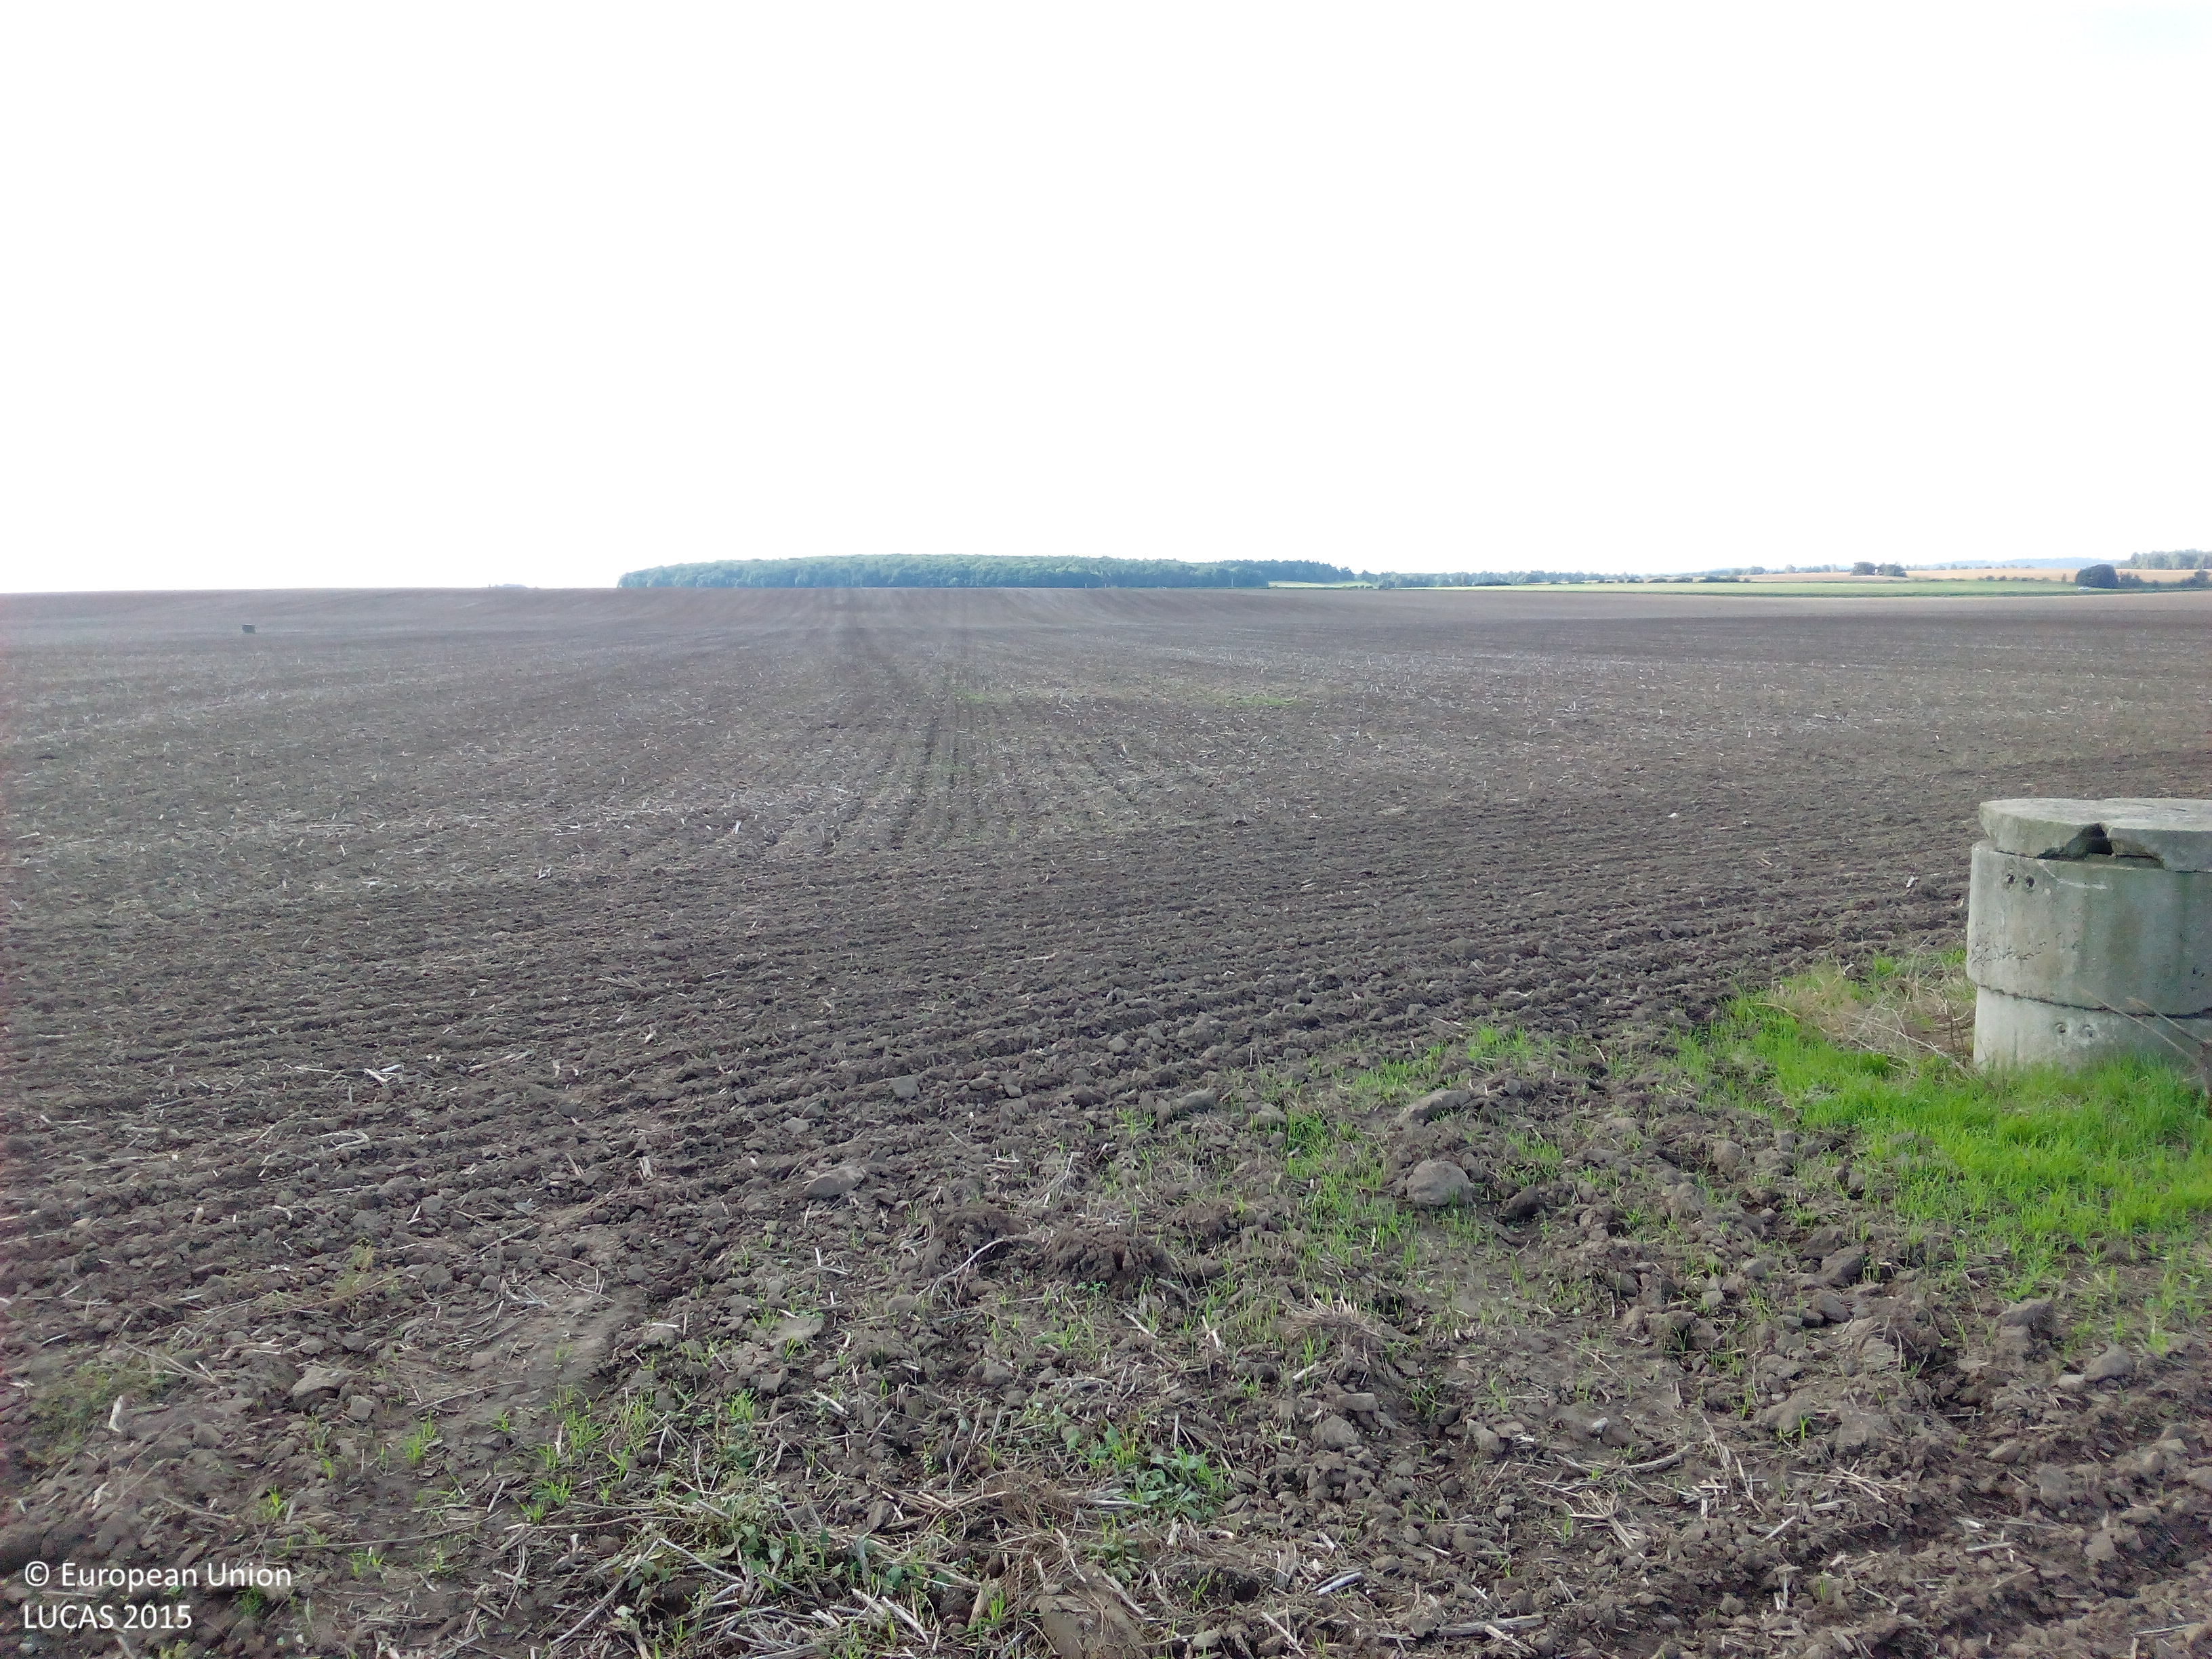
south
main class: Cropland
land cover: Rape and turnip rape
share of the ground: < 10 %
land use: Agriculture (excluding fallow land and kitchen gardens)
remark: Harvested field
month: September
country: DE
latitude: 51.8704
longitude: 10.9437
